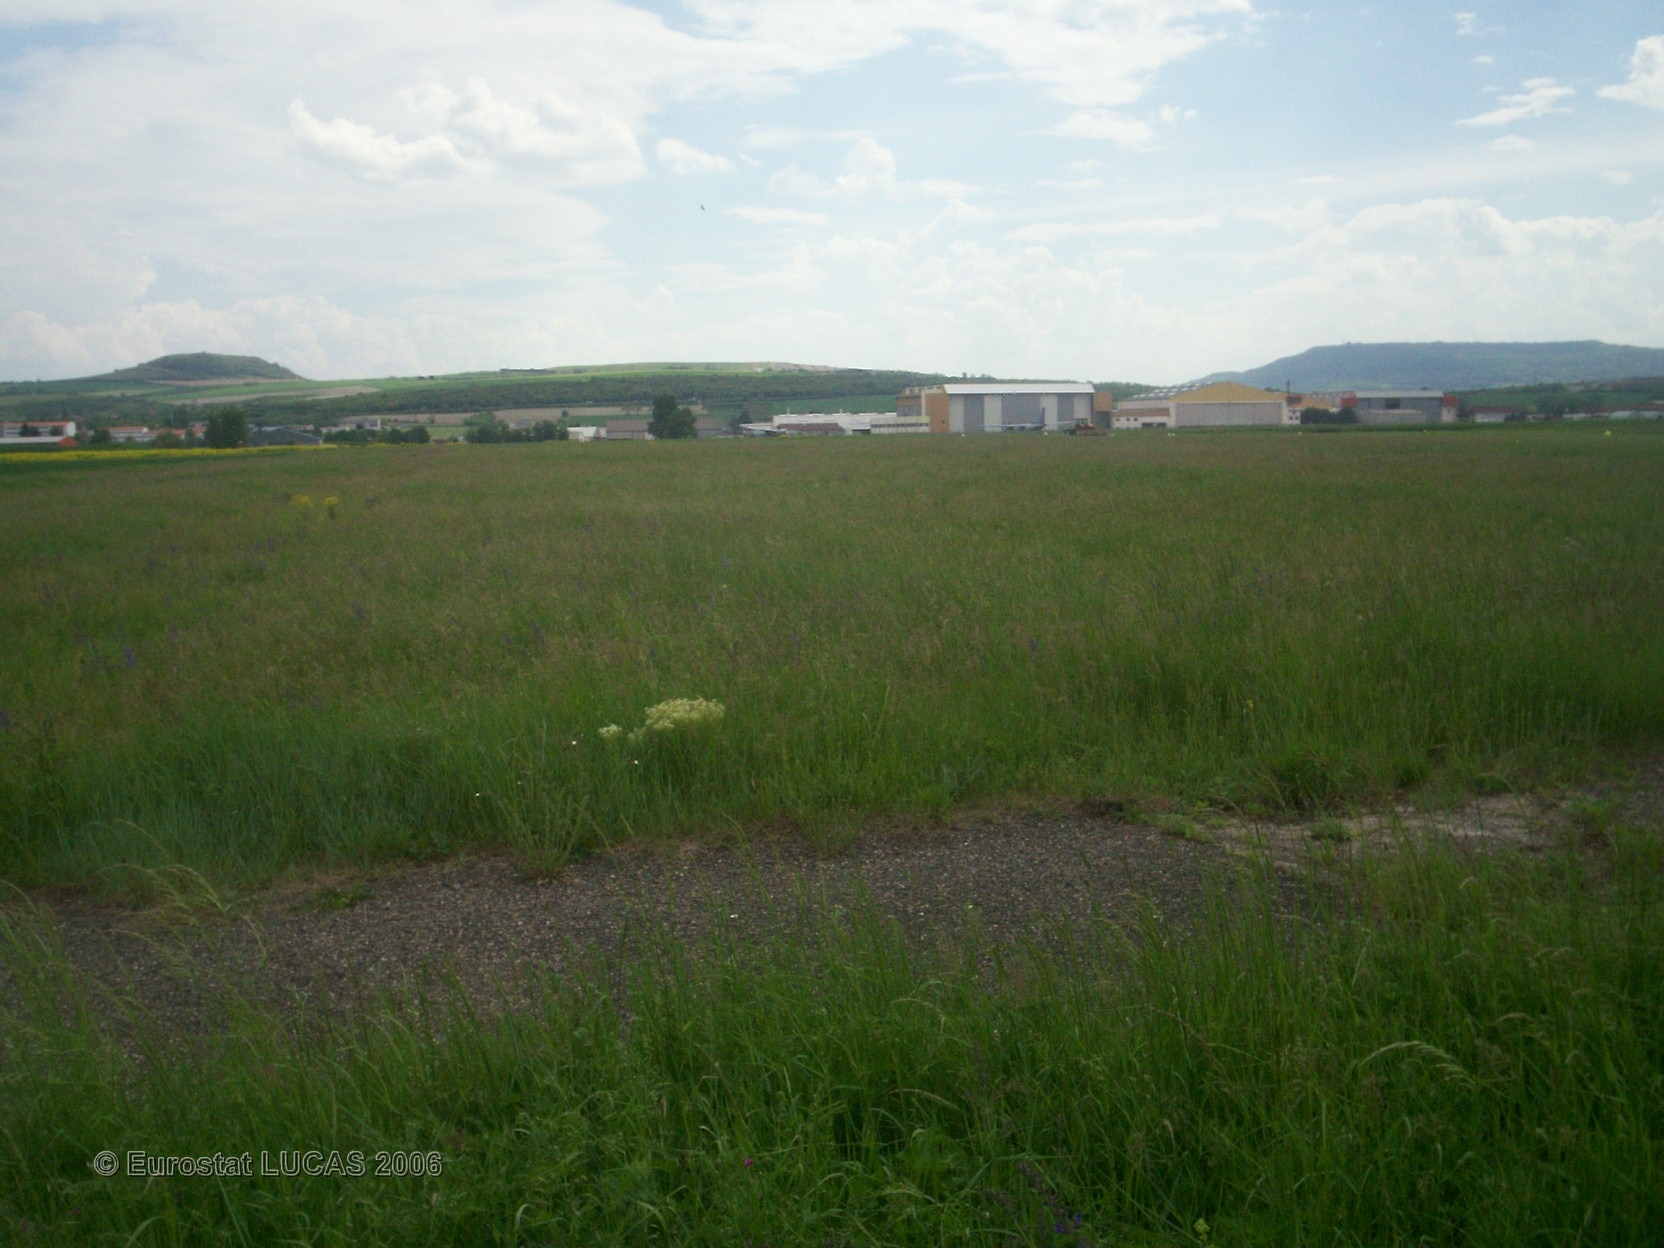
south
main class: Grassland
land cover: Grassland without tree/shrub cover
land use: Air transport
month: May
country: FR
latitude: 45.7893
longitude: 3.1693
